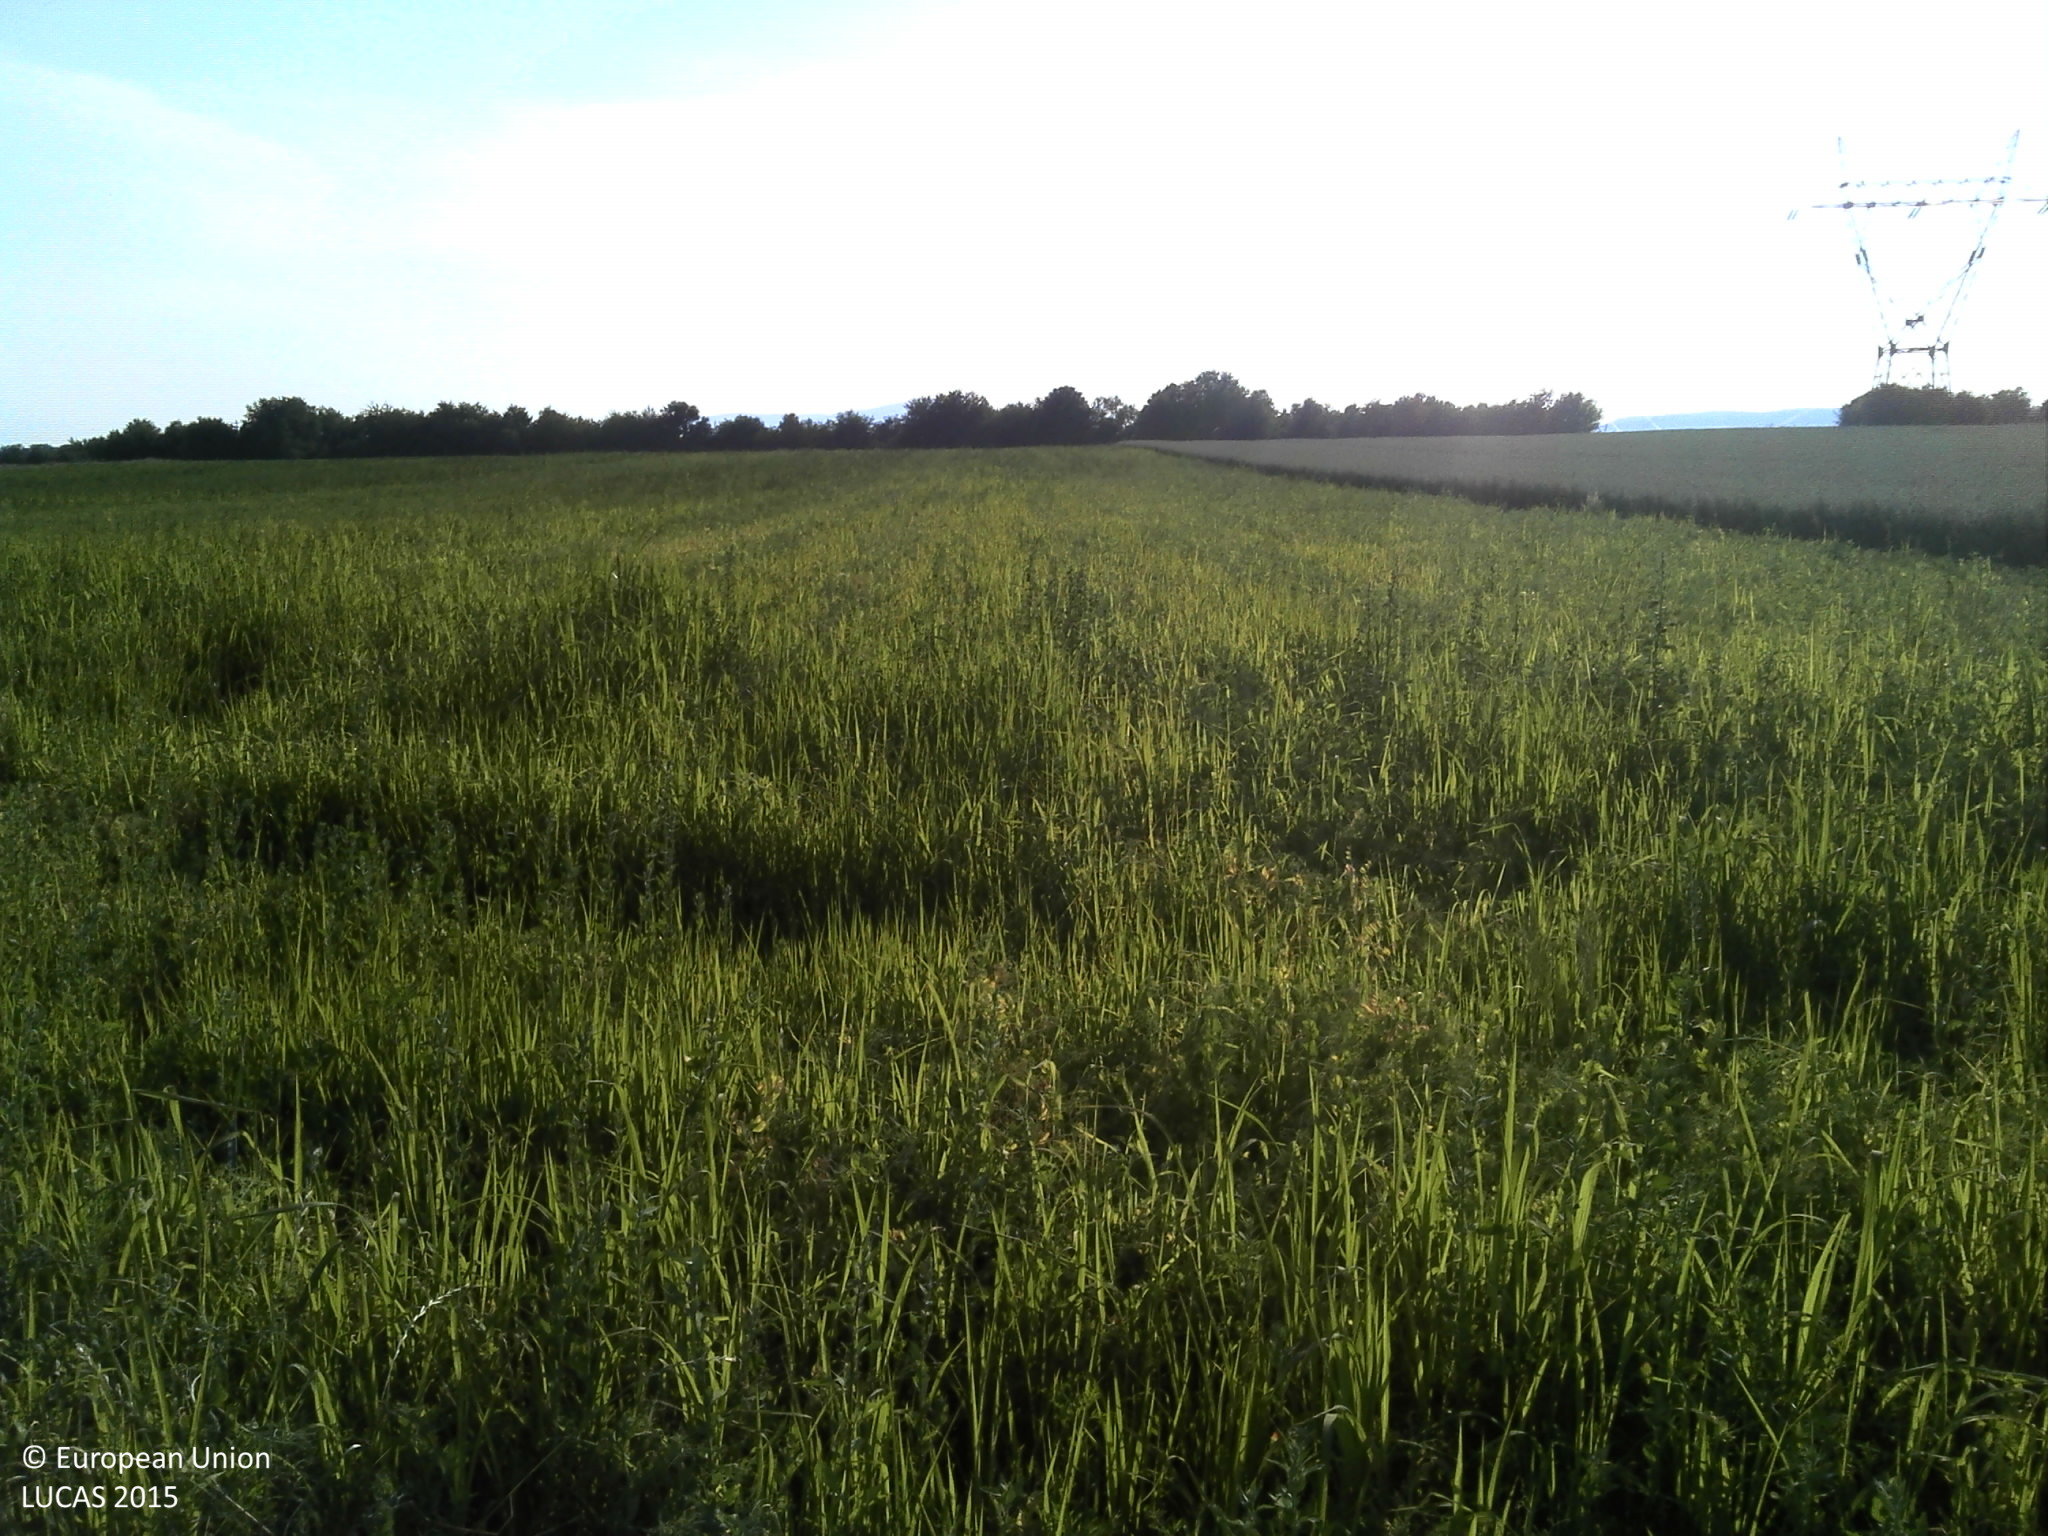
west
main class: Grassland
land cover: Spontaneously vegetated surfaces
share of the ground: > 75 %
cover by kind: herbaceous plants 100 %
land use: Agriculture (excluding fallow land and kitchen gardens)
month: June
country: HR
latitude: 45.4288
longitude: 17.6067
